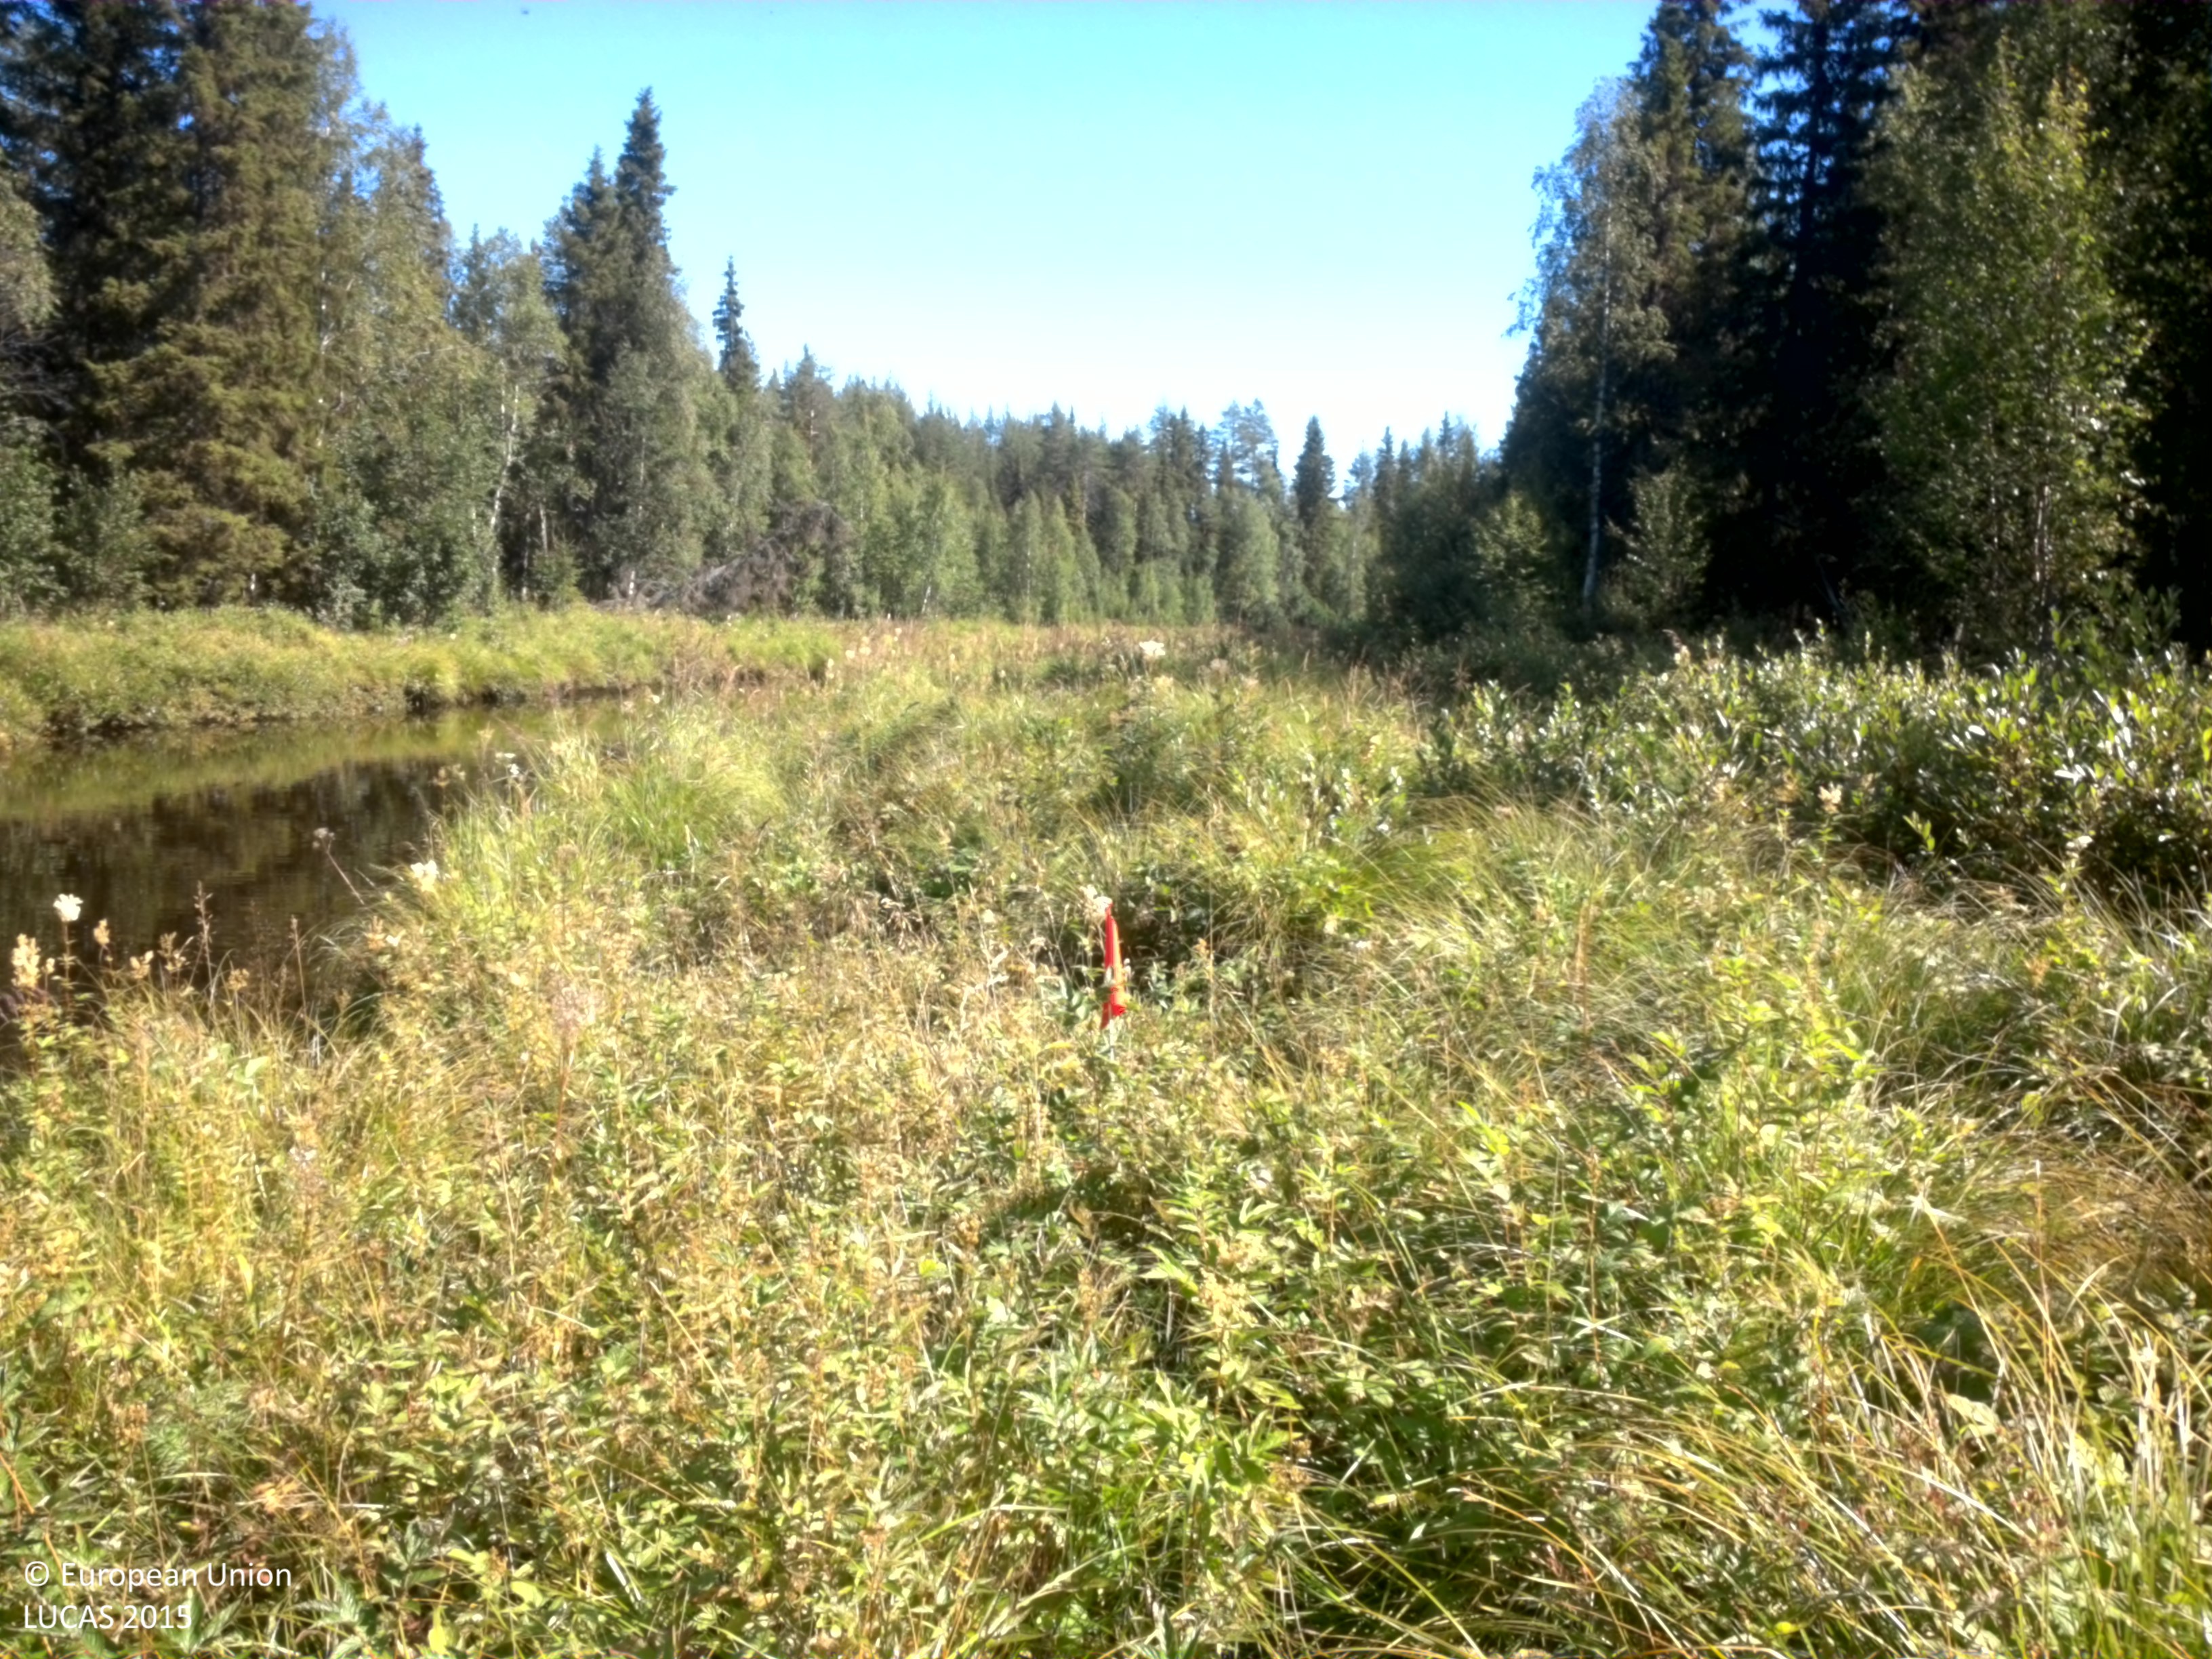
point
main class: Grassland
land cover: Grassland with sparse tree/shrub cover
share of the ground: > 75 %
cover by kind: herbaceous plants 95 %, broadleaved forest trees 5 %
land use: Semi-natural and natural areas not in use
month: August
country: SE
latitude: 64.3262
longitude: 18.6380
